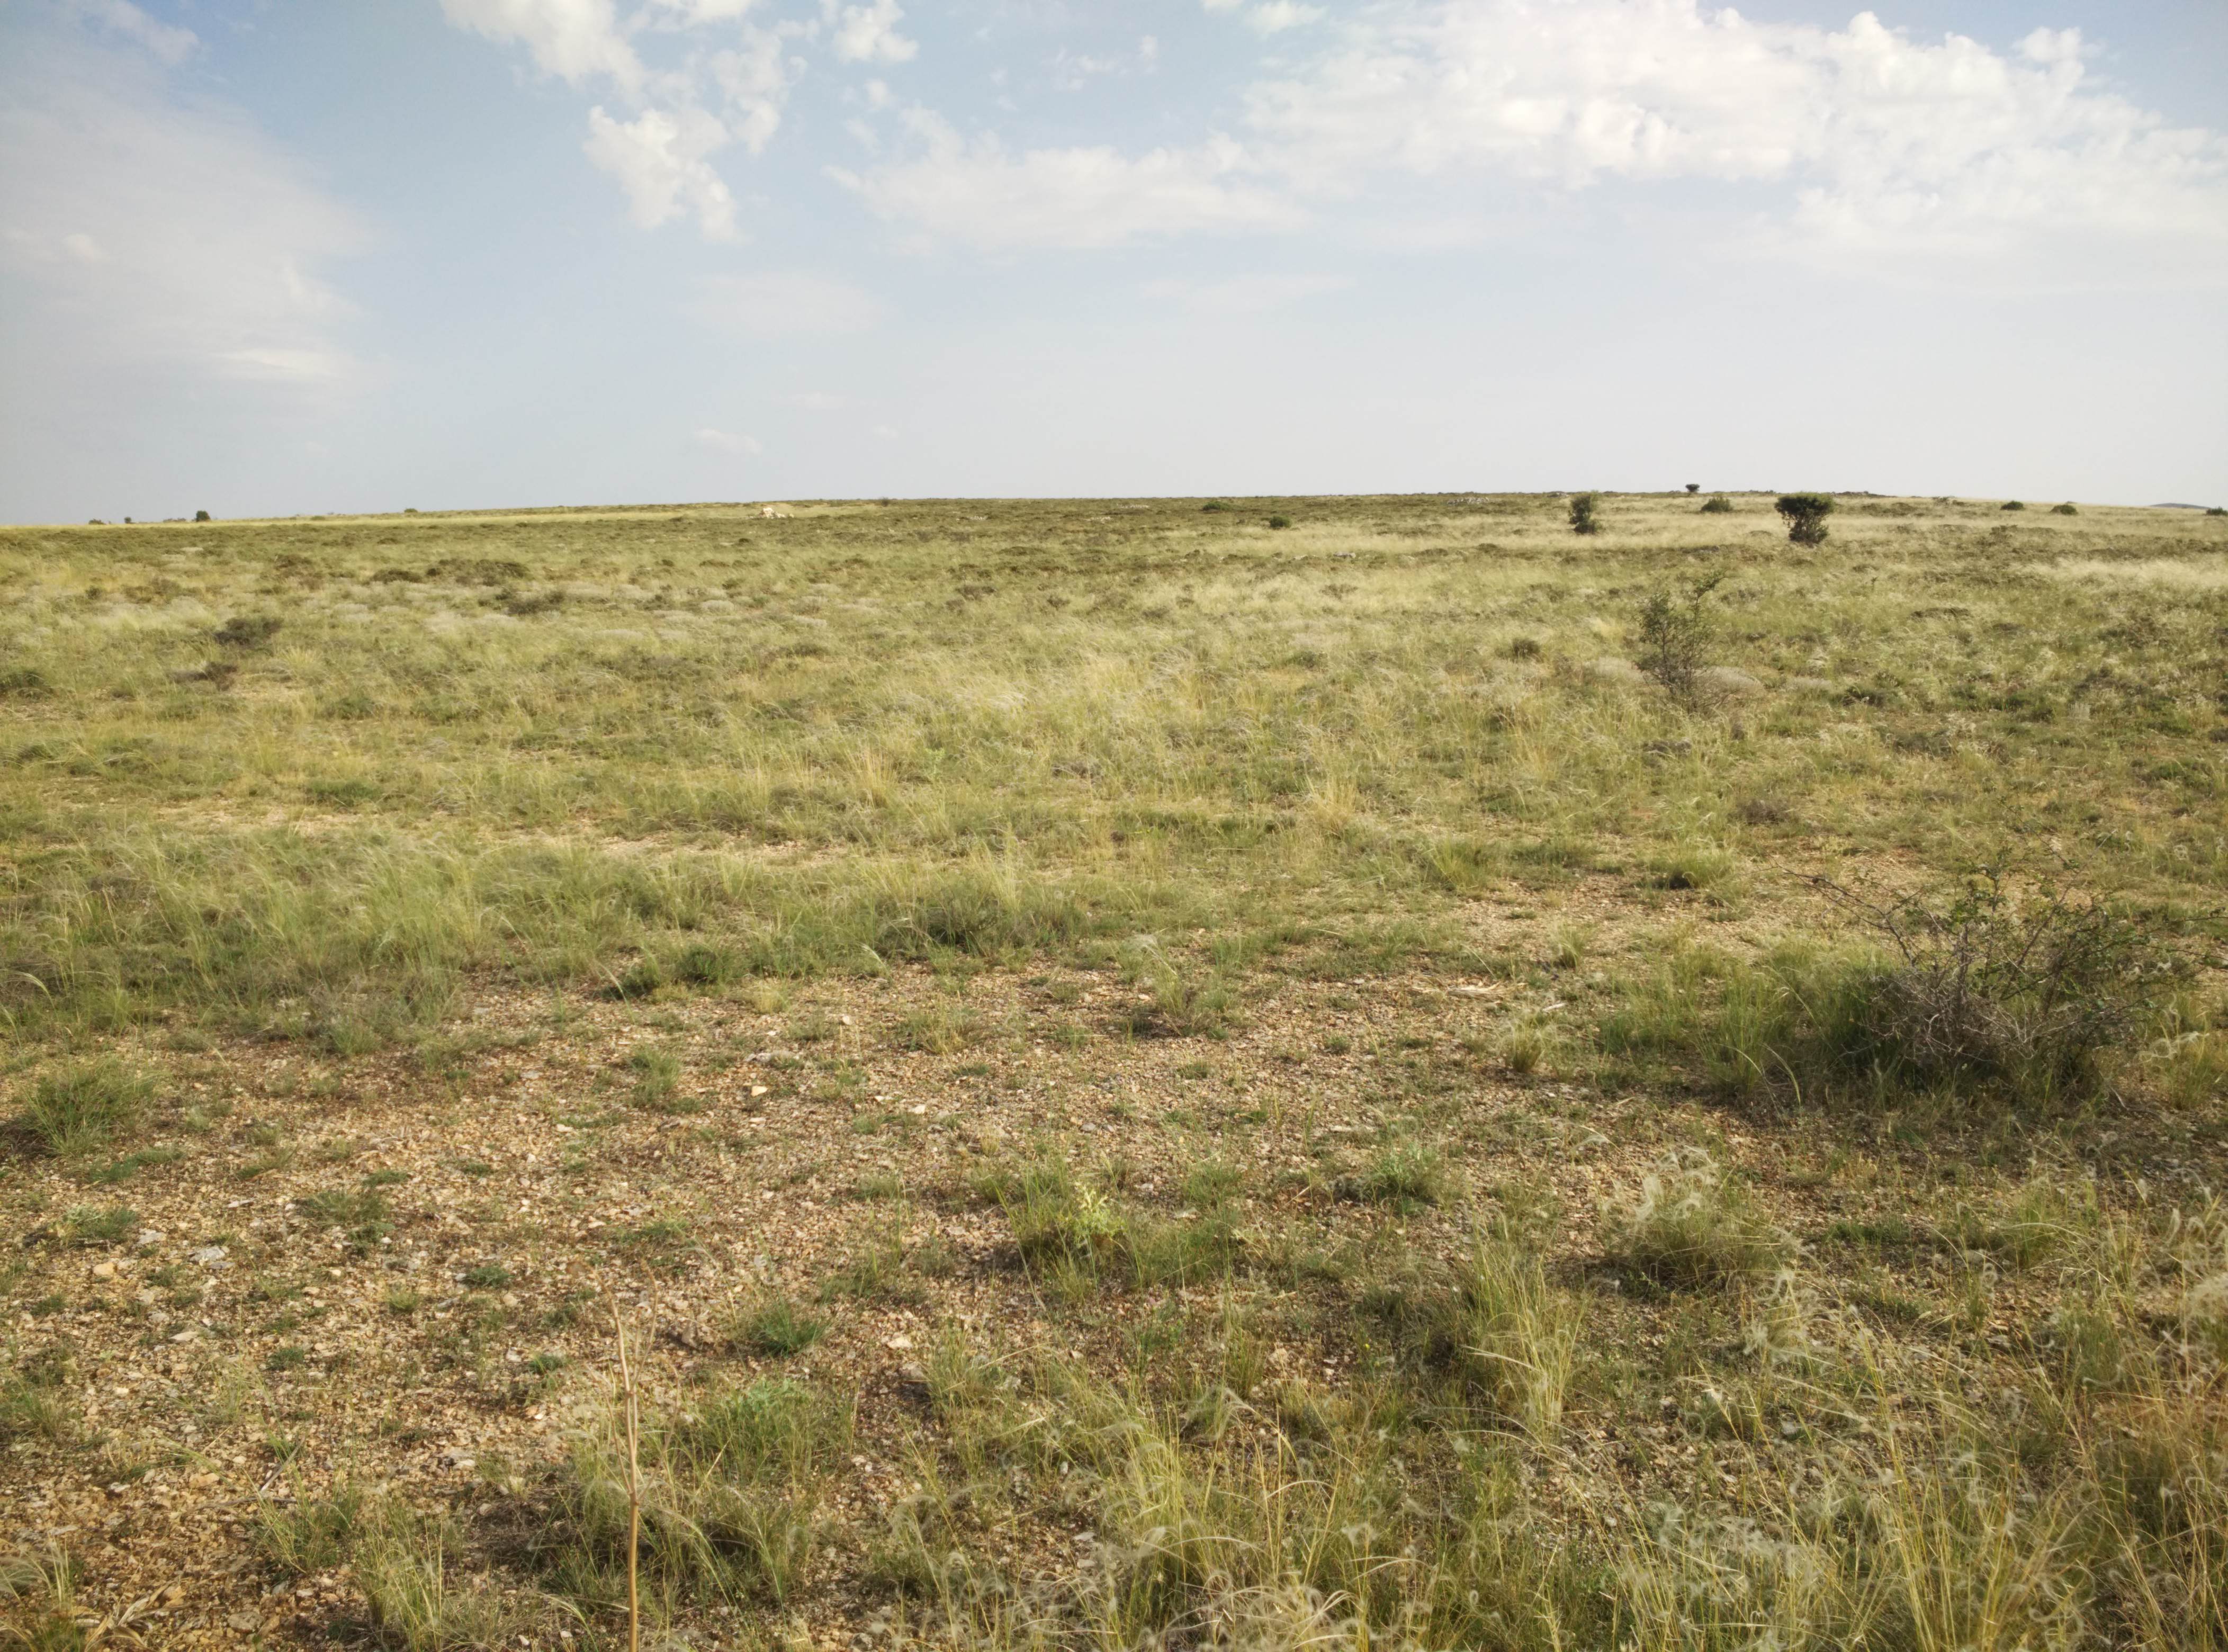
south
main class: Shrubland
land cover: Shrubland without tree cover
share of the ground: 50 - 75 %
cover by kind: shrubs 50 %, unconsolidated bare surface 45 %, herbaceous plants 5 %
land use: Agriculture (excluding fallow land and kitchen gardens)
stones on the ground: 25 - 50 %
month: July
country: ES
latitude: 40.9861
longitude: -1.8739
